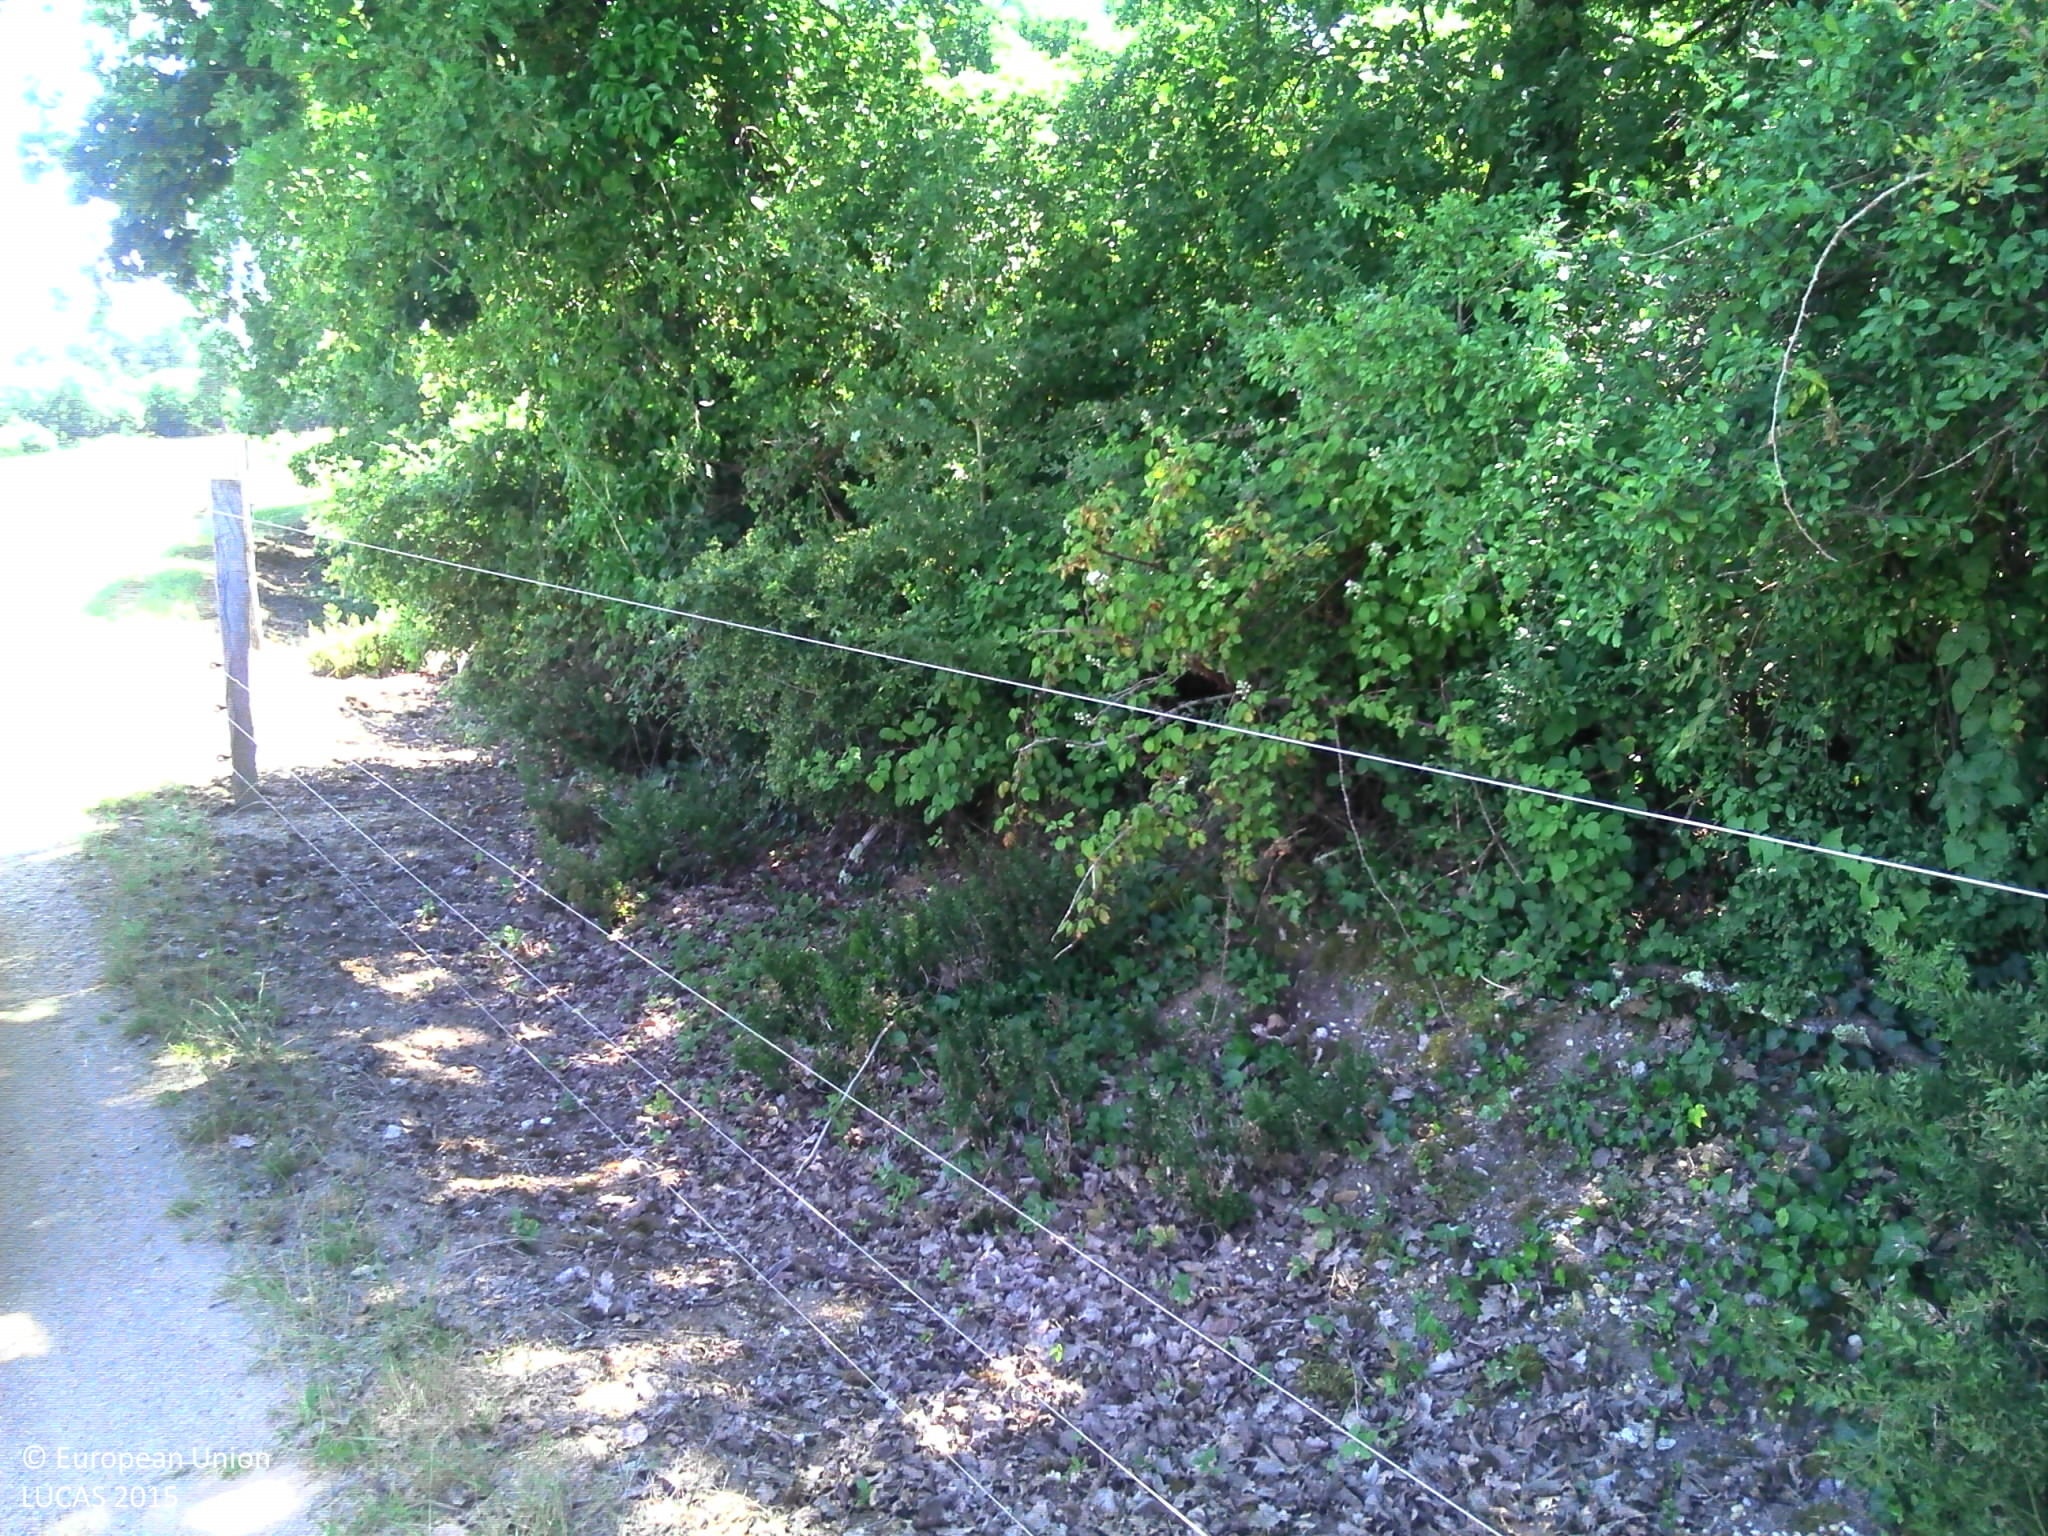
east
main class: Woodland
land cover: Broadleaved woodland
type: acidophilous oak and oak-birch forest
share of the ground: > 75 %
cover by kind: broadleaved forest trees 100 %
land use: Forestry
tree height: > 5 m
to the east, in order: Broadleaved woodland; Grass margins; Inland fresh water bodies; Grassland with sparse tree/shrub cover; Inland fresh water bodies; Grassland with sparse tree/shrub cover; Inland fresh water bodies
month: June
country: FR
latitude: 46.7248
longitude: 0.4955
